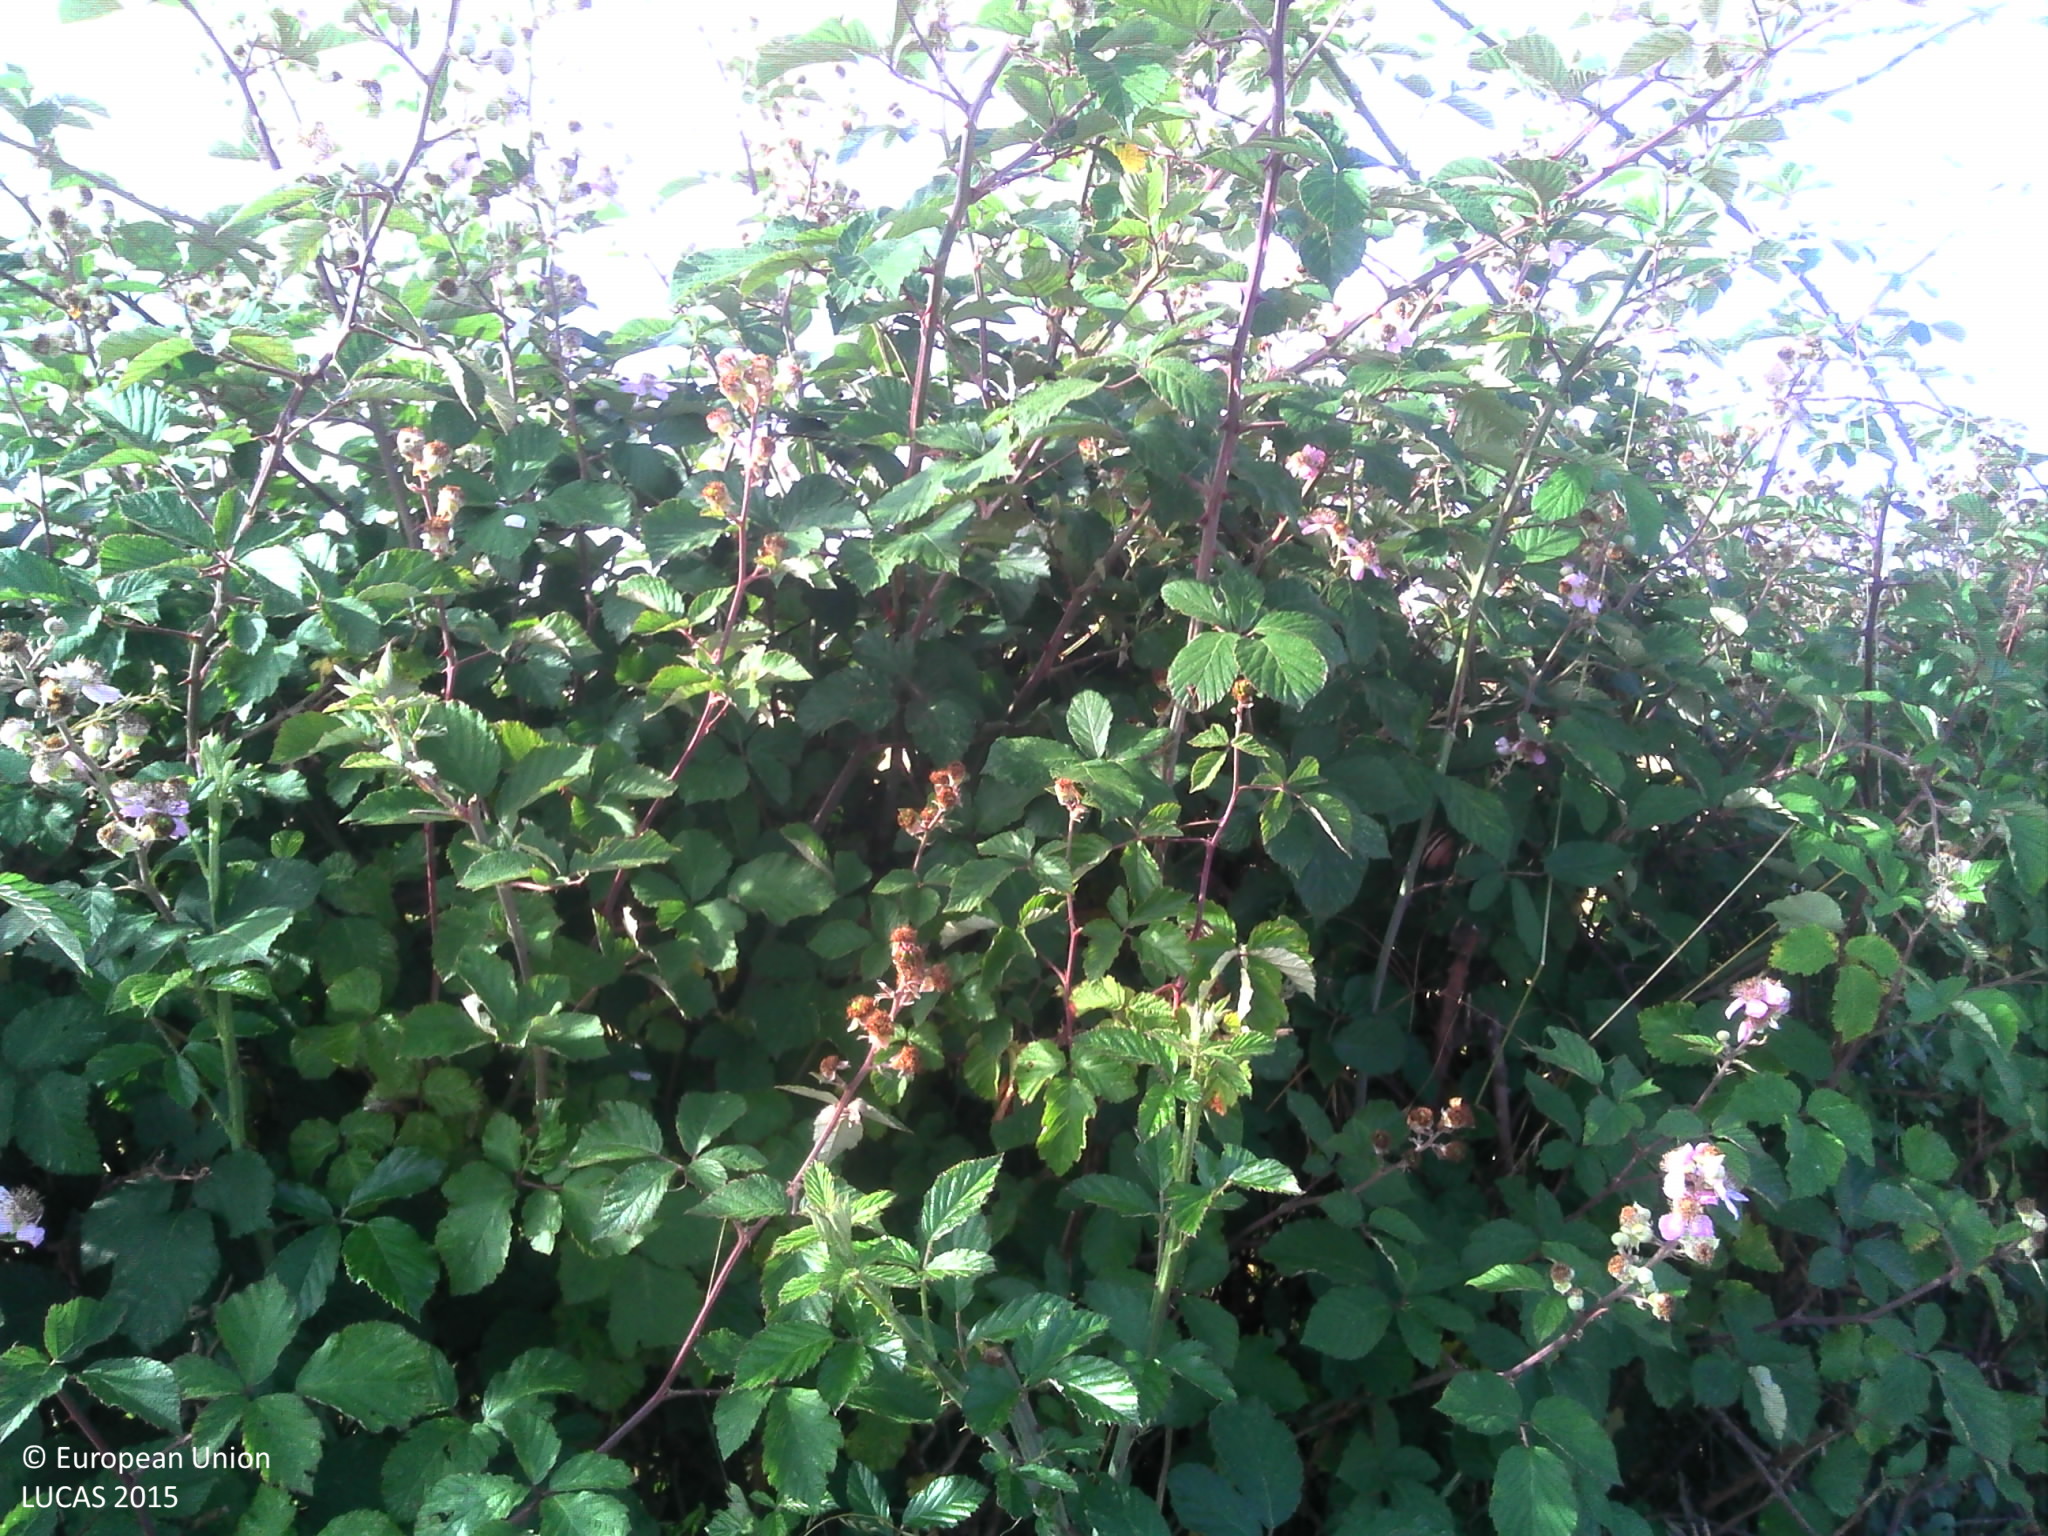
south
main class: Grassland
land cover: Grassland without tree/shrub cover
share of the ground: > 75 %
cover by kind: herbaceous plants 100 %
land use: Agriculture (excluding fallow land and kitchen gardens)
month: June
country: FR
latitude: 46.7303
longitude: 4.8064
